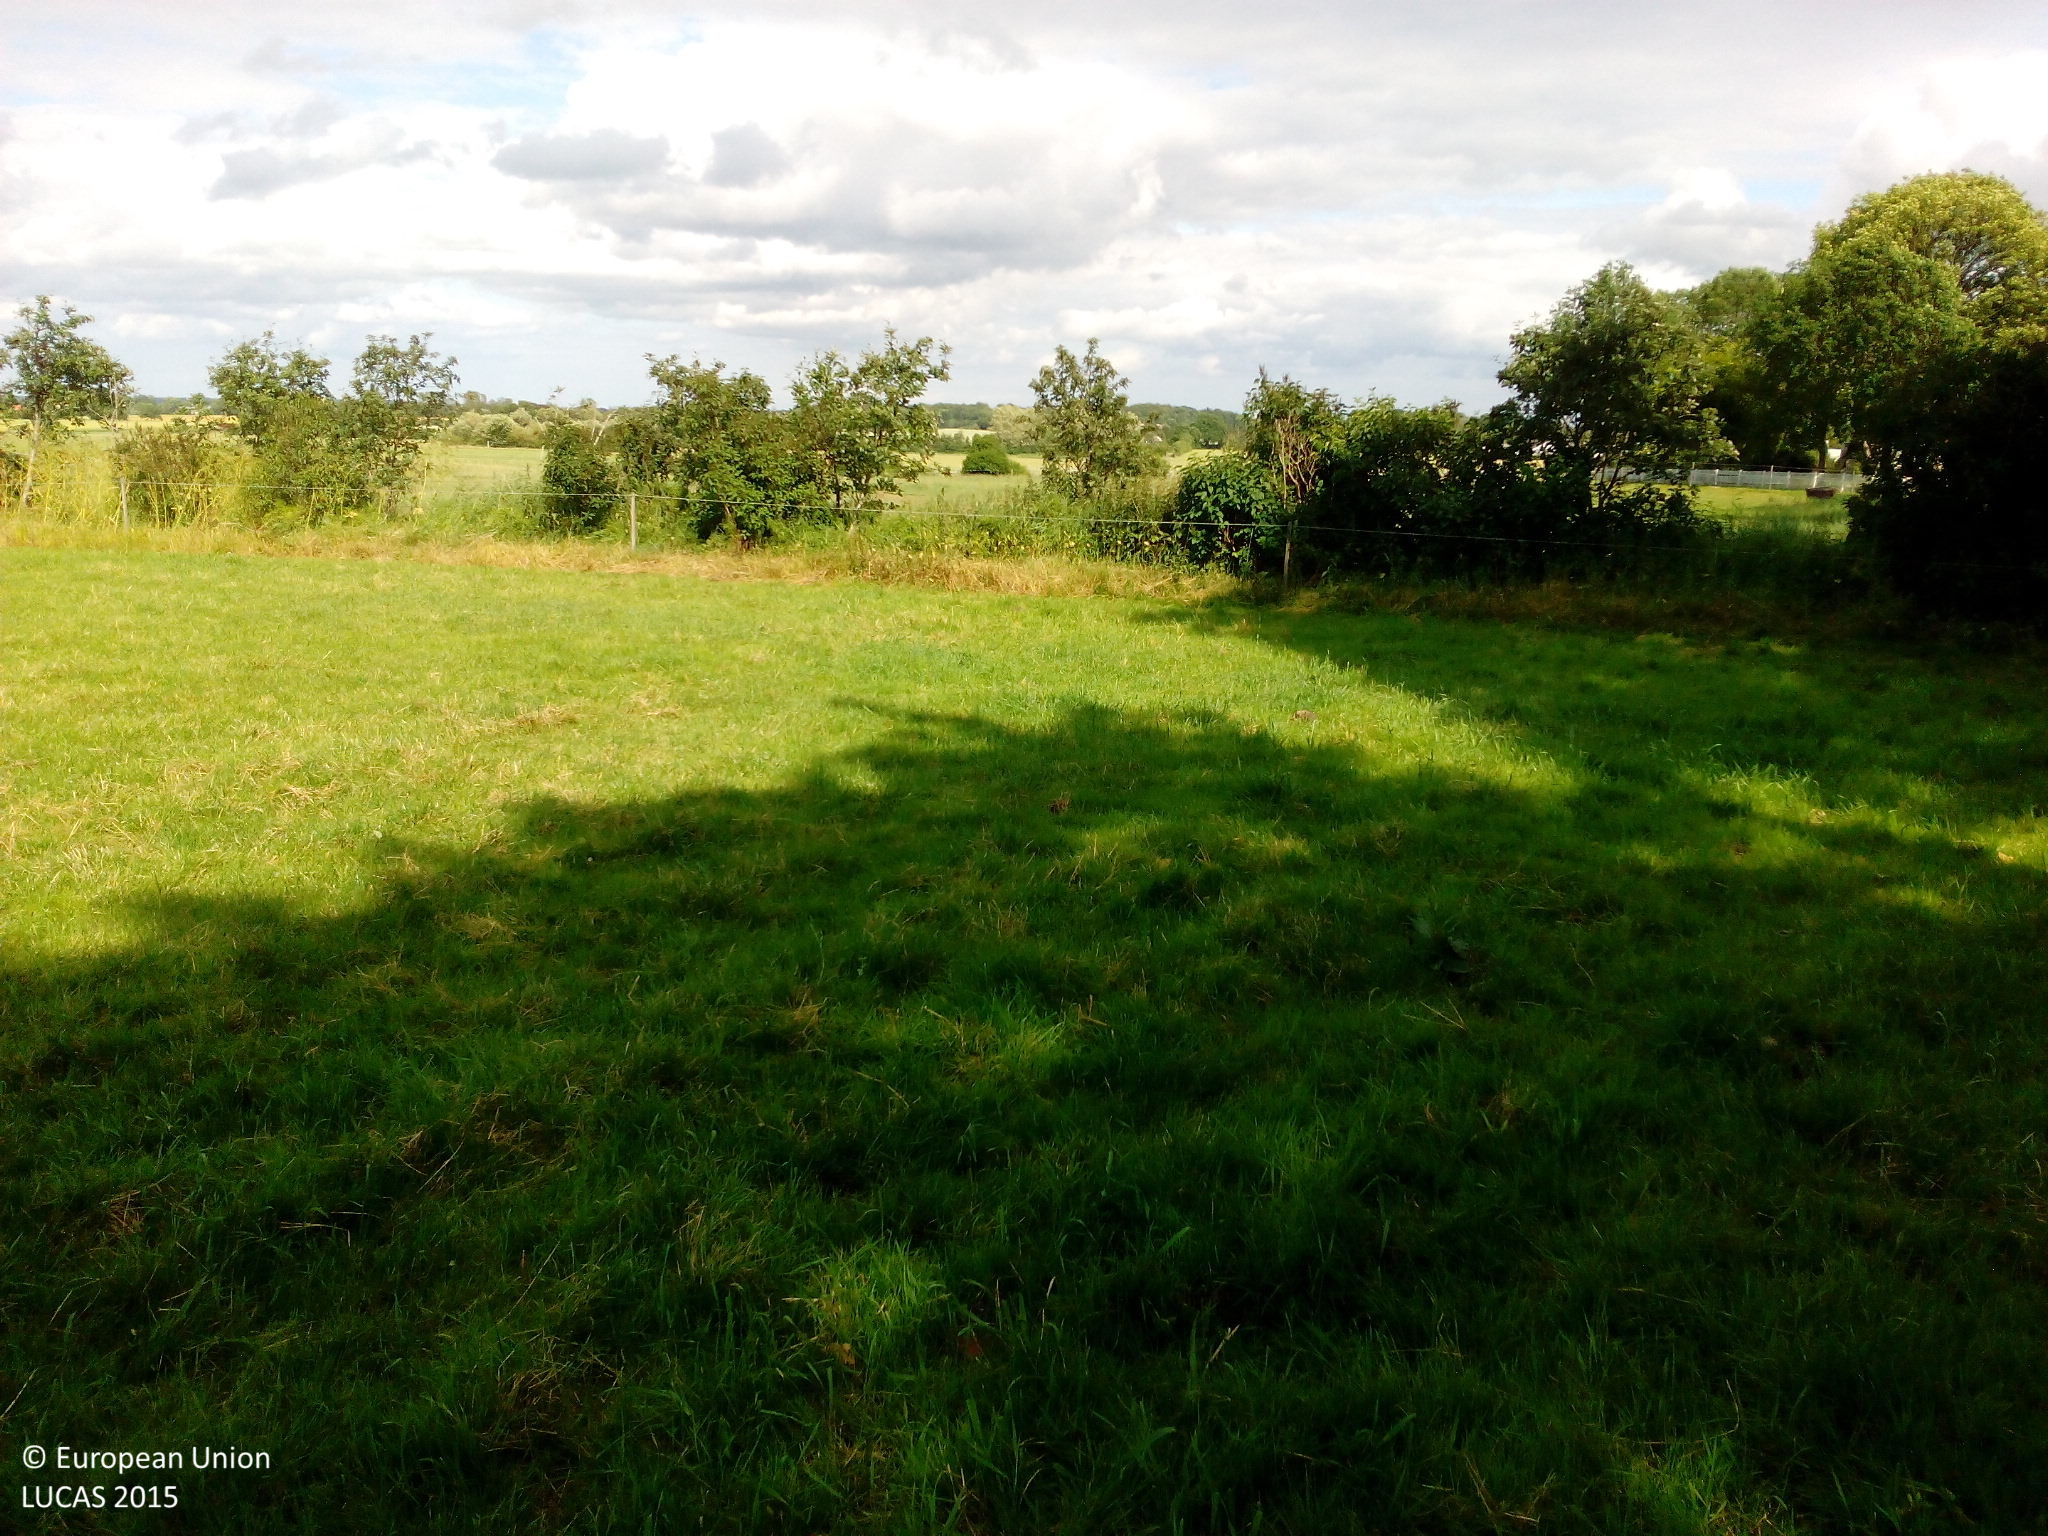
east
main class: Grassland
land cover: Grassland without tree/shrub cover
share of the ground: > 75 %
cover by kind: herbaceous plants 100 %
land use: Agriculture (excluding fallow land and kitchen gardens)
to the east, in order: Grassland without tree/shrub cover; Fences; Broadleaved woodland; Fences; Grassland without tree/shrub cover; Fences; Grassland without tree/shrub cover; Fences; Broadleaved woodland; Fences; Other bare soil; Grass margins; Fences; Grass margins; Other bare soil; Grass margins; Fences; Grass margins; Other bare soil; Grass margins; Fences; Grass margins; Other bare soil
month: July
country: DK
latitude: 55.2907
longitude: 12.0299
